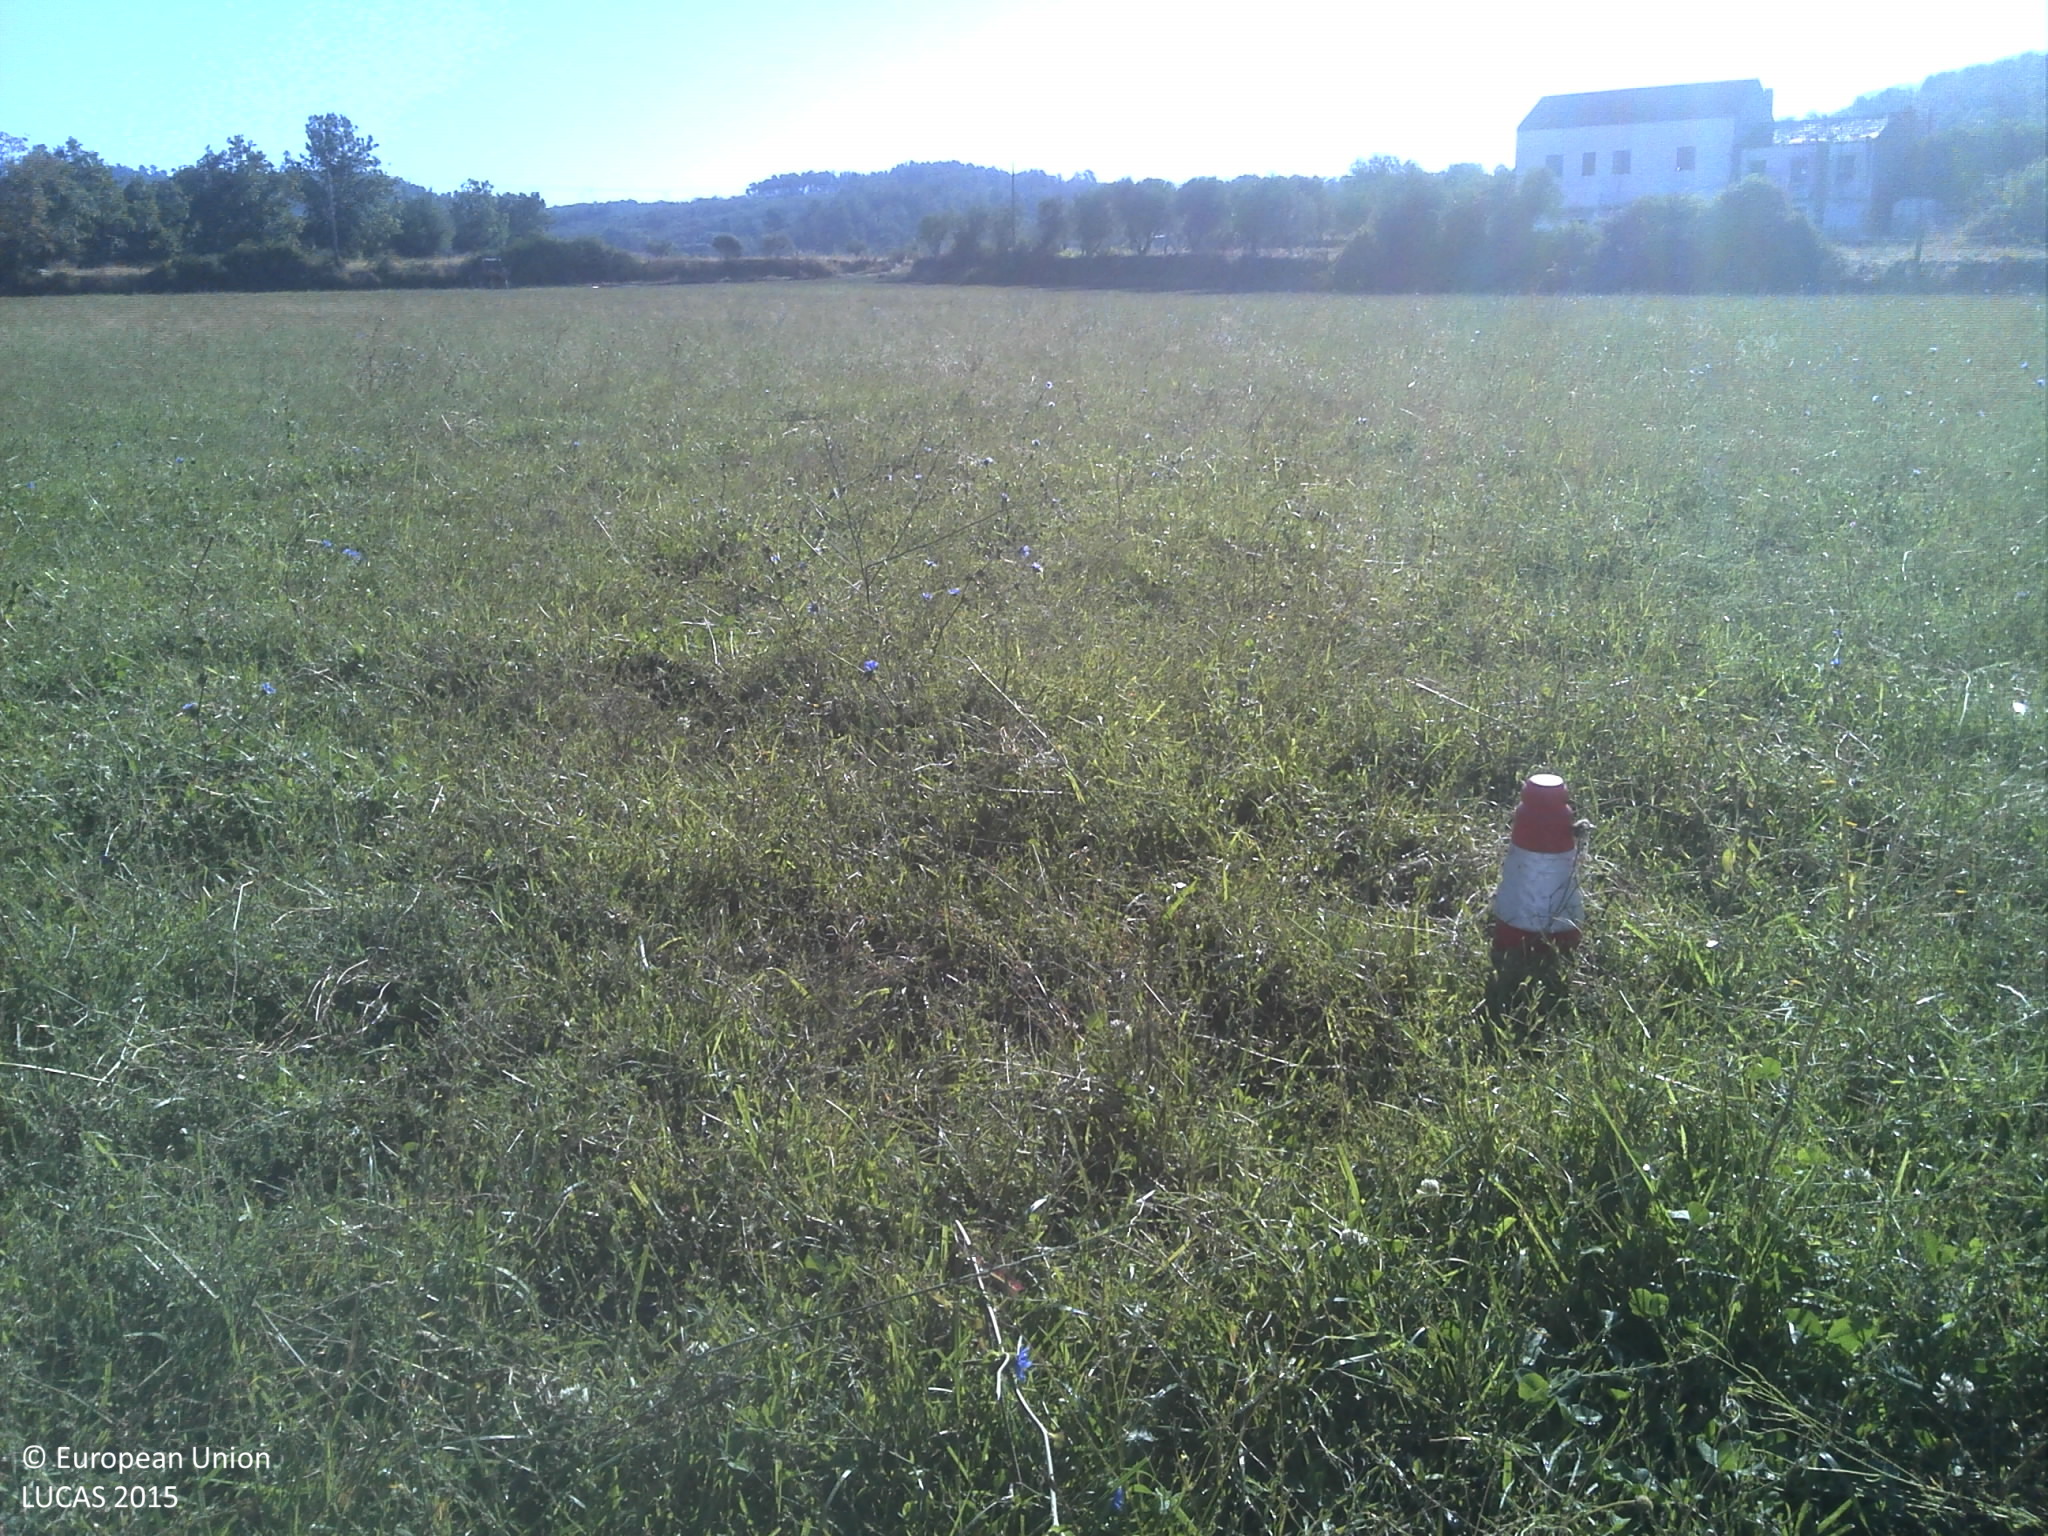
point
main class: Grassland
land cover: Spontaneously vegetated surfaces
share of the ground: > 75 %
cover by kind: herbaceous plants 80 %, unconsolidated bare surface 20 %
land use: Agriculture (excluding fallow land and kitchen gardens)
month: July
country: PT
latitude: 40.3714
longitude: -7.3349
